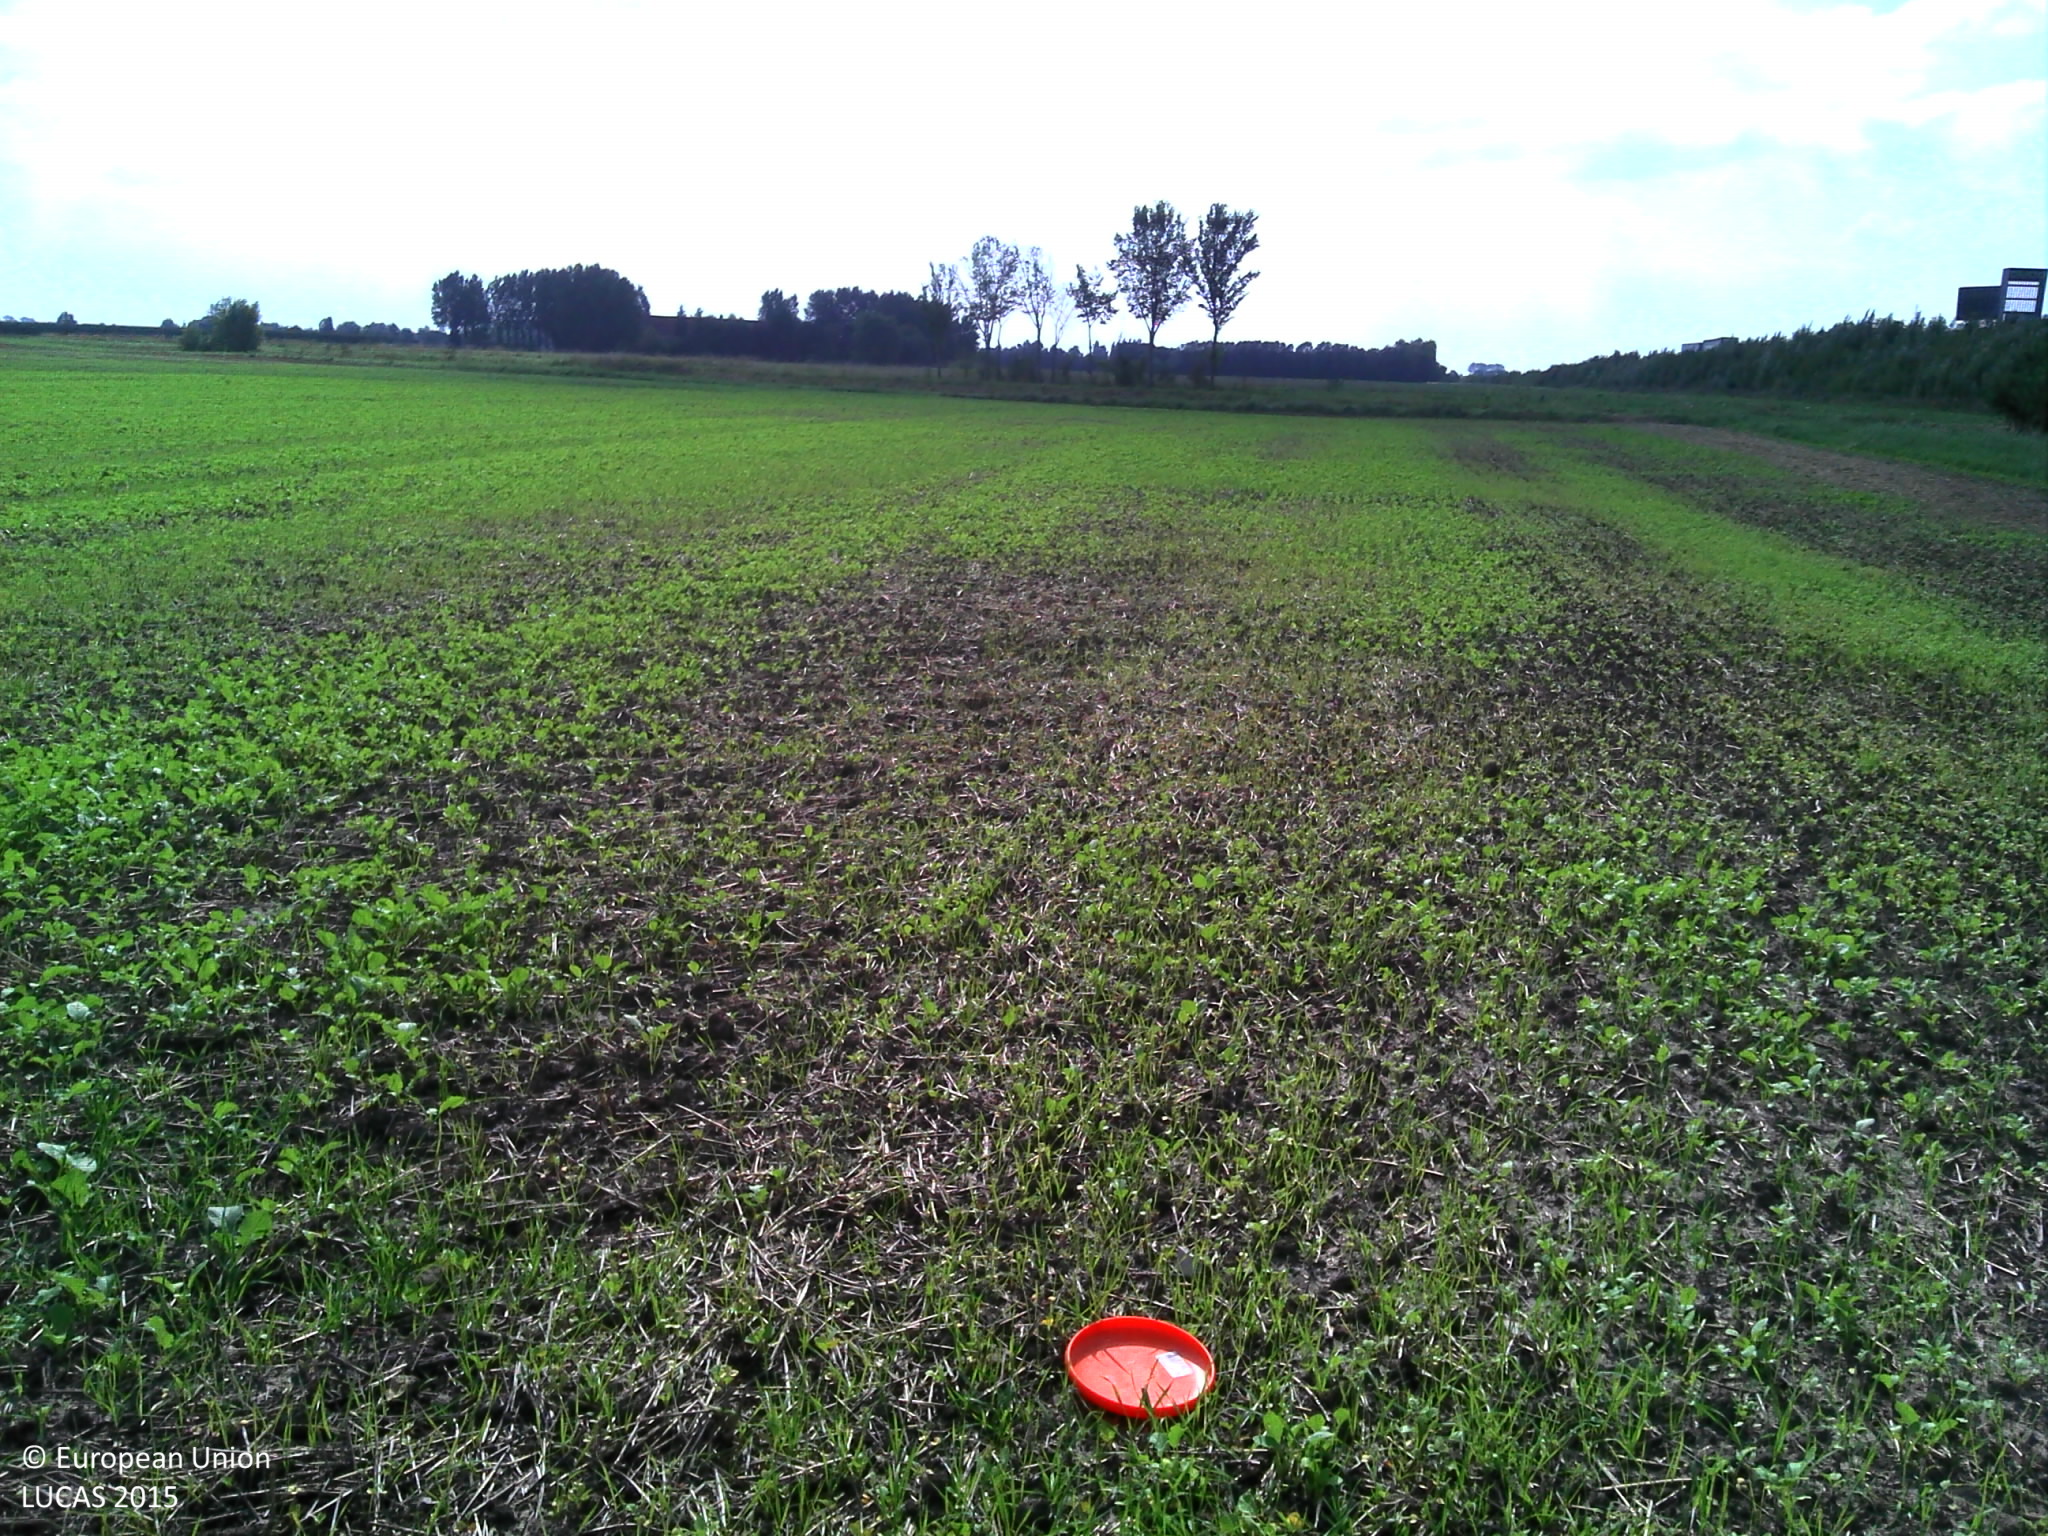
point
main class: Cropland
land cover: Common wheat
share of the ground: 25 - 50 %
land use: Agriculture (excluding fallow land and kitchen gardens)
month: September
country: BE
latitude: 51.0692
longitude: 2.6958
